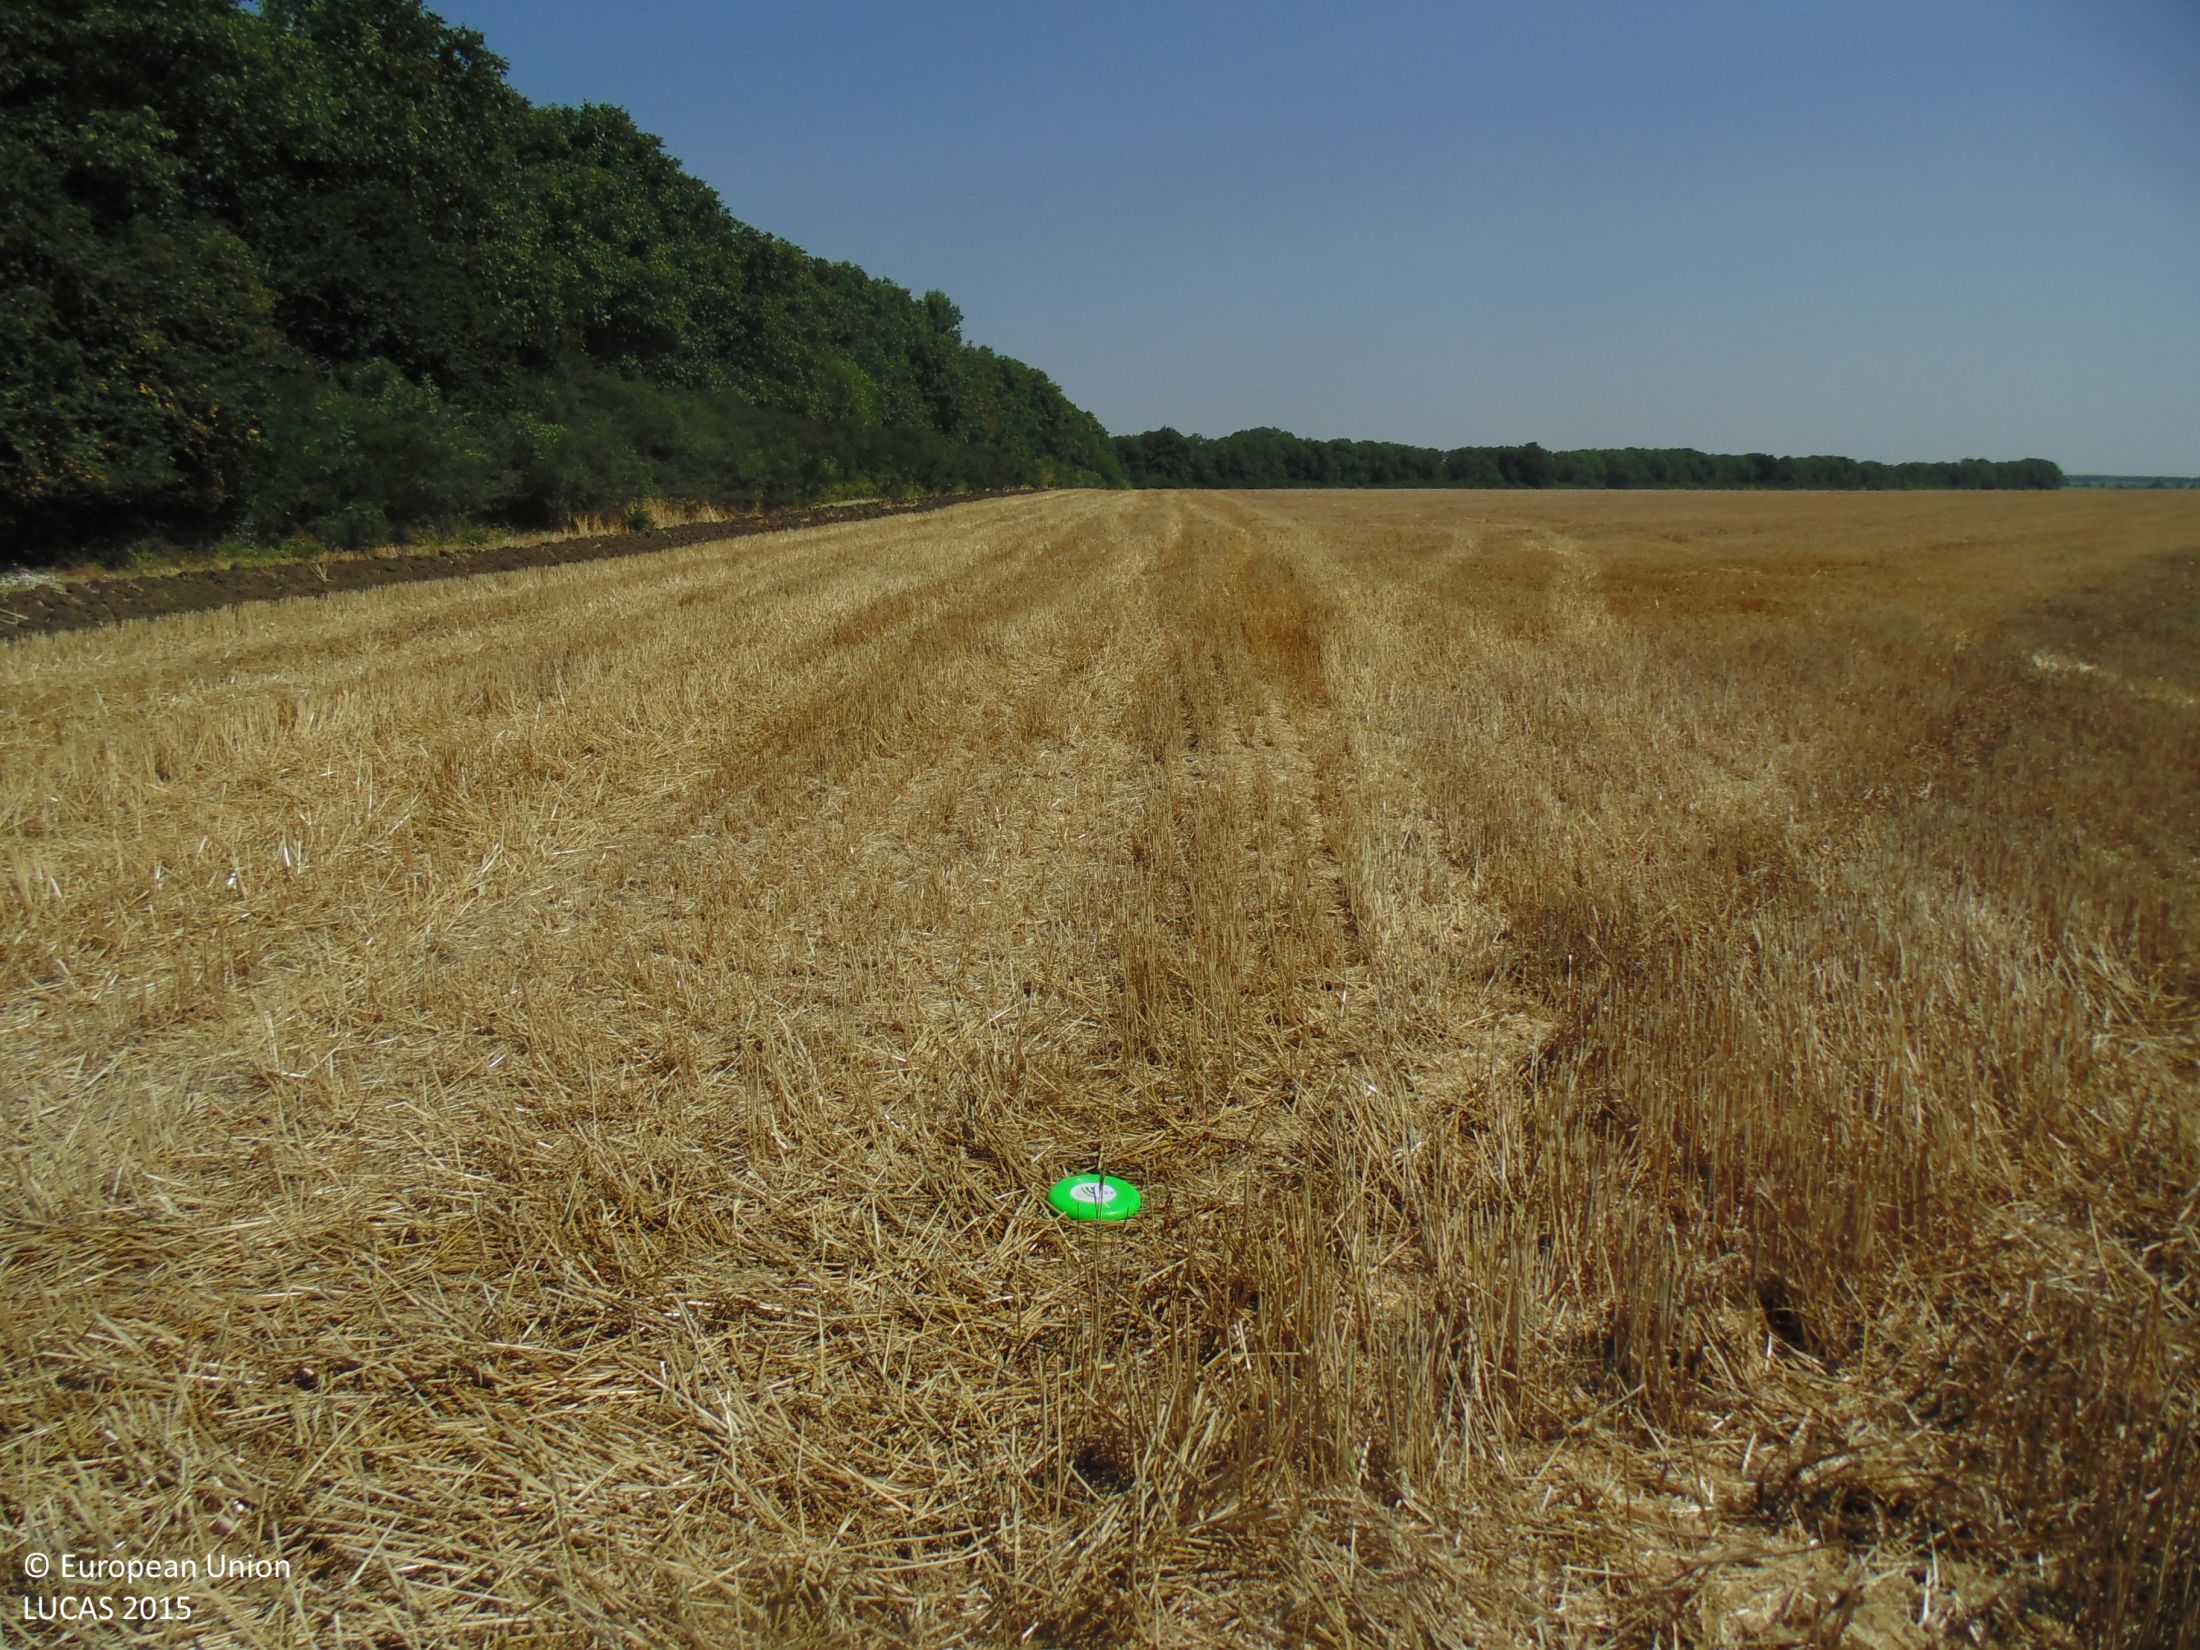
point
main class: Cropland
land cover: Common wheat
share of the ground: > 75 %
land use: Agriculture (excluding fallow land and kitchen gardens)
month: July
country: BG
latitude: 43.6644
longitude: 27.6861
